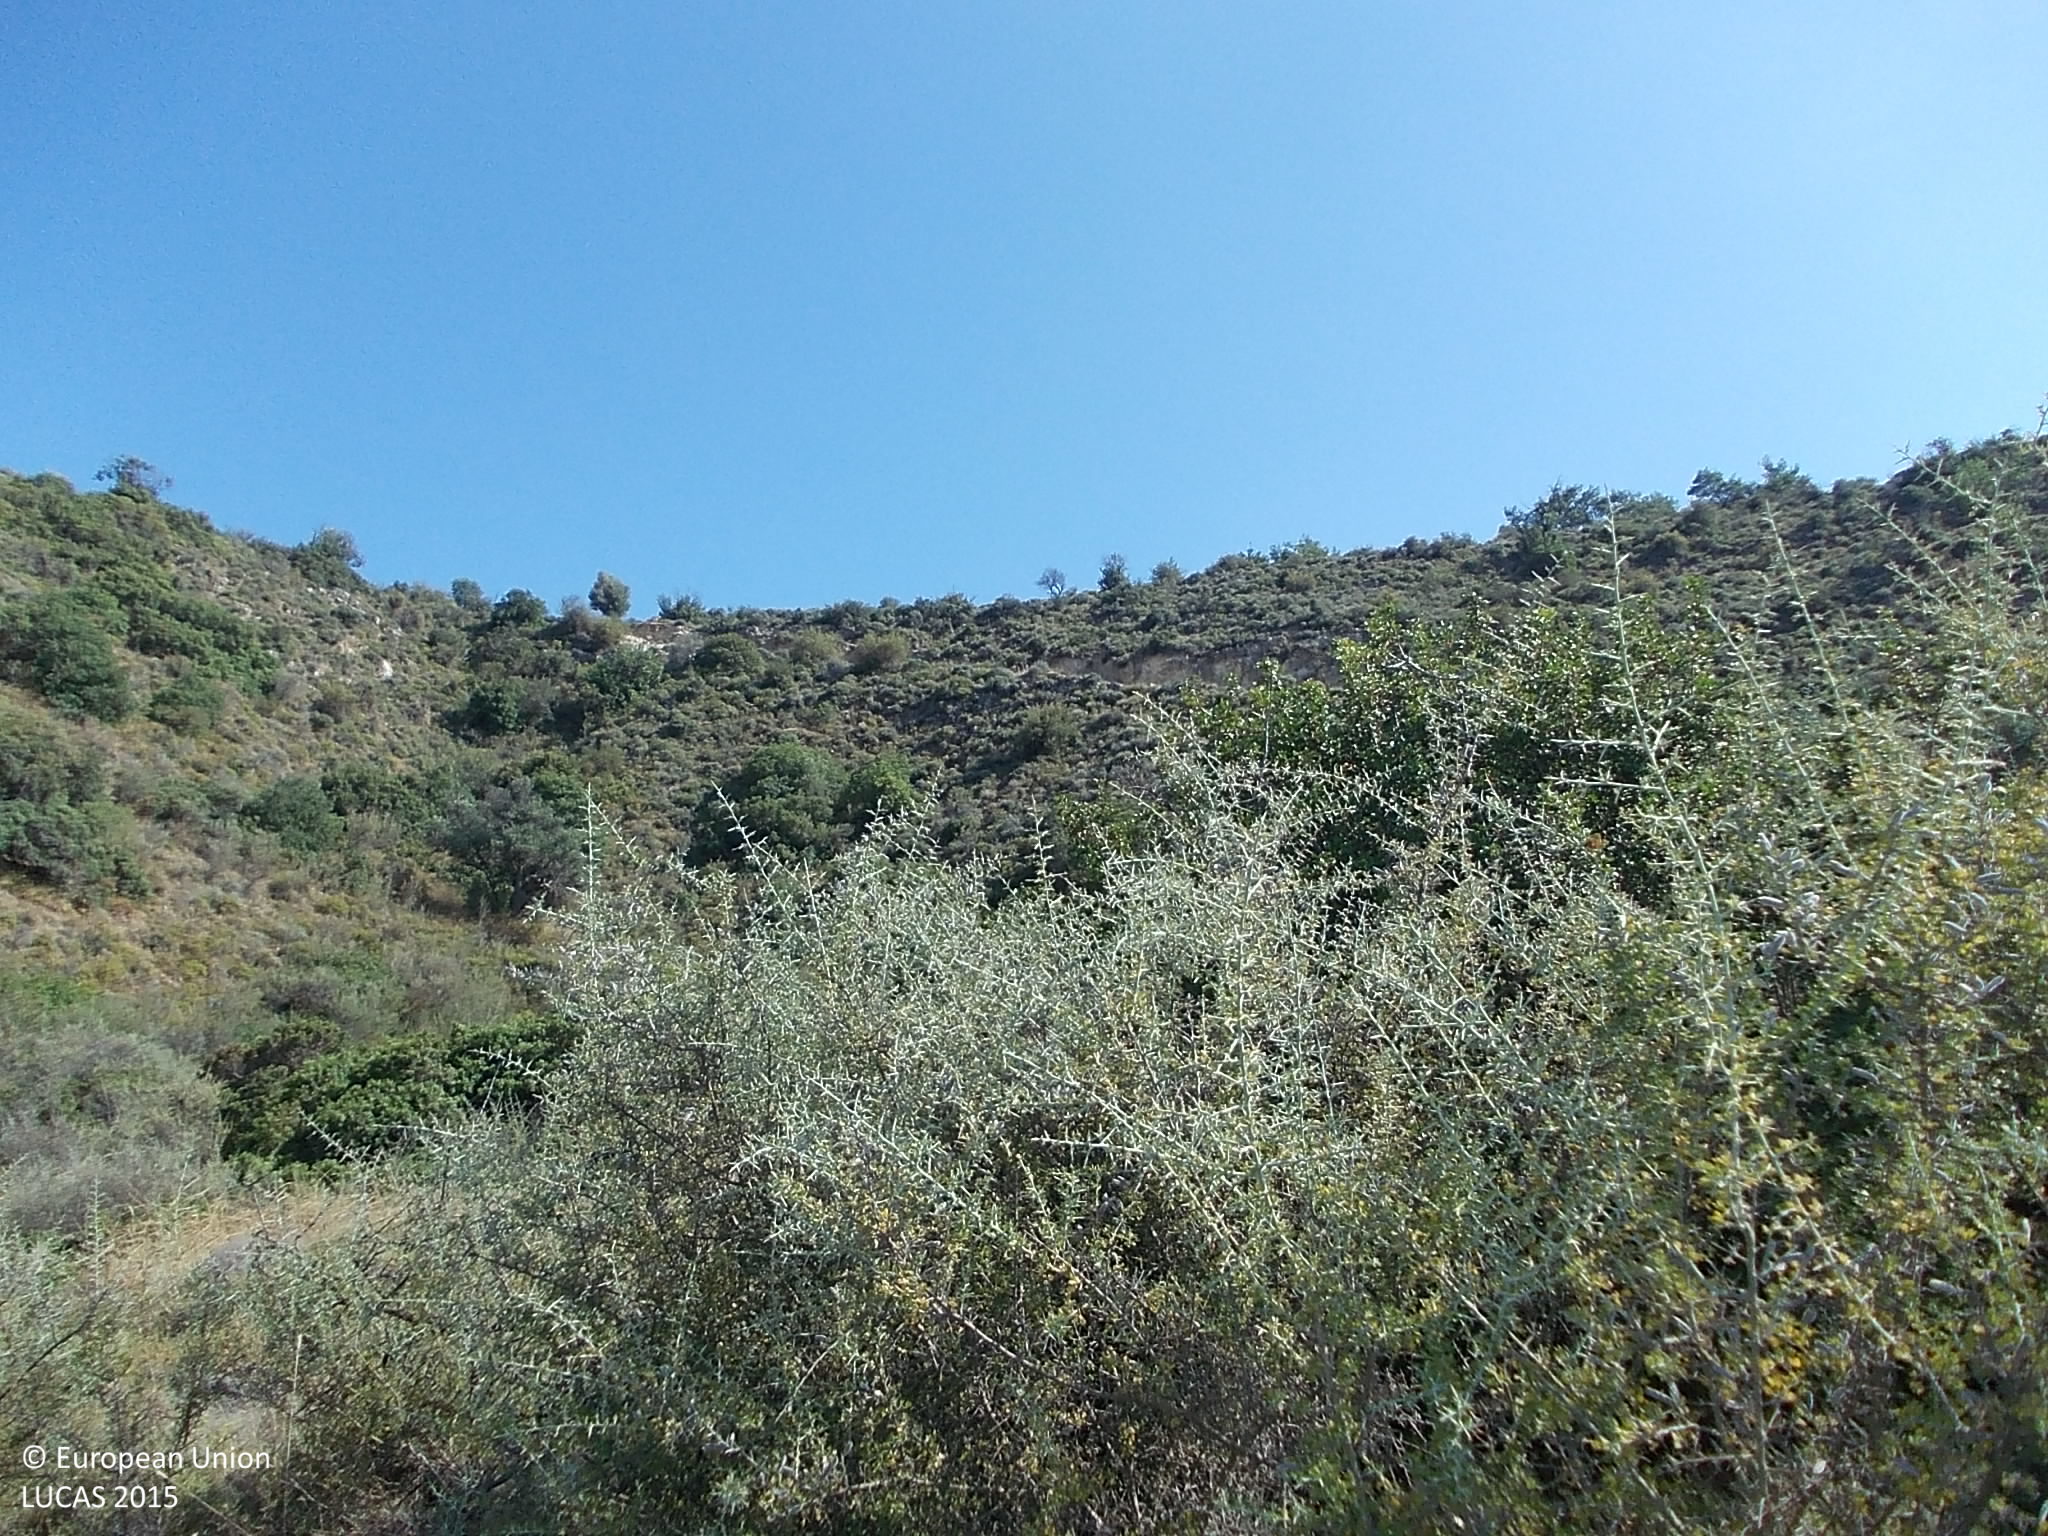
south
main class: Shrubland
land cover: Shrubland without tree cover
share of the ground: > 75 %
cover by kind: shrubs 95 %, herbaceous plants 5 %
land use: Semi-natural and natural areas not in use
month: June
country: CY
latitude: 34.6623
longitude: 32.7067
